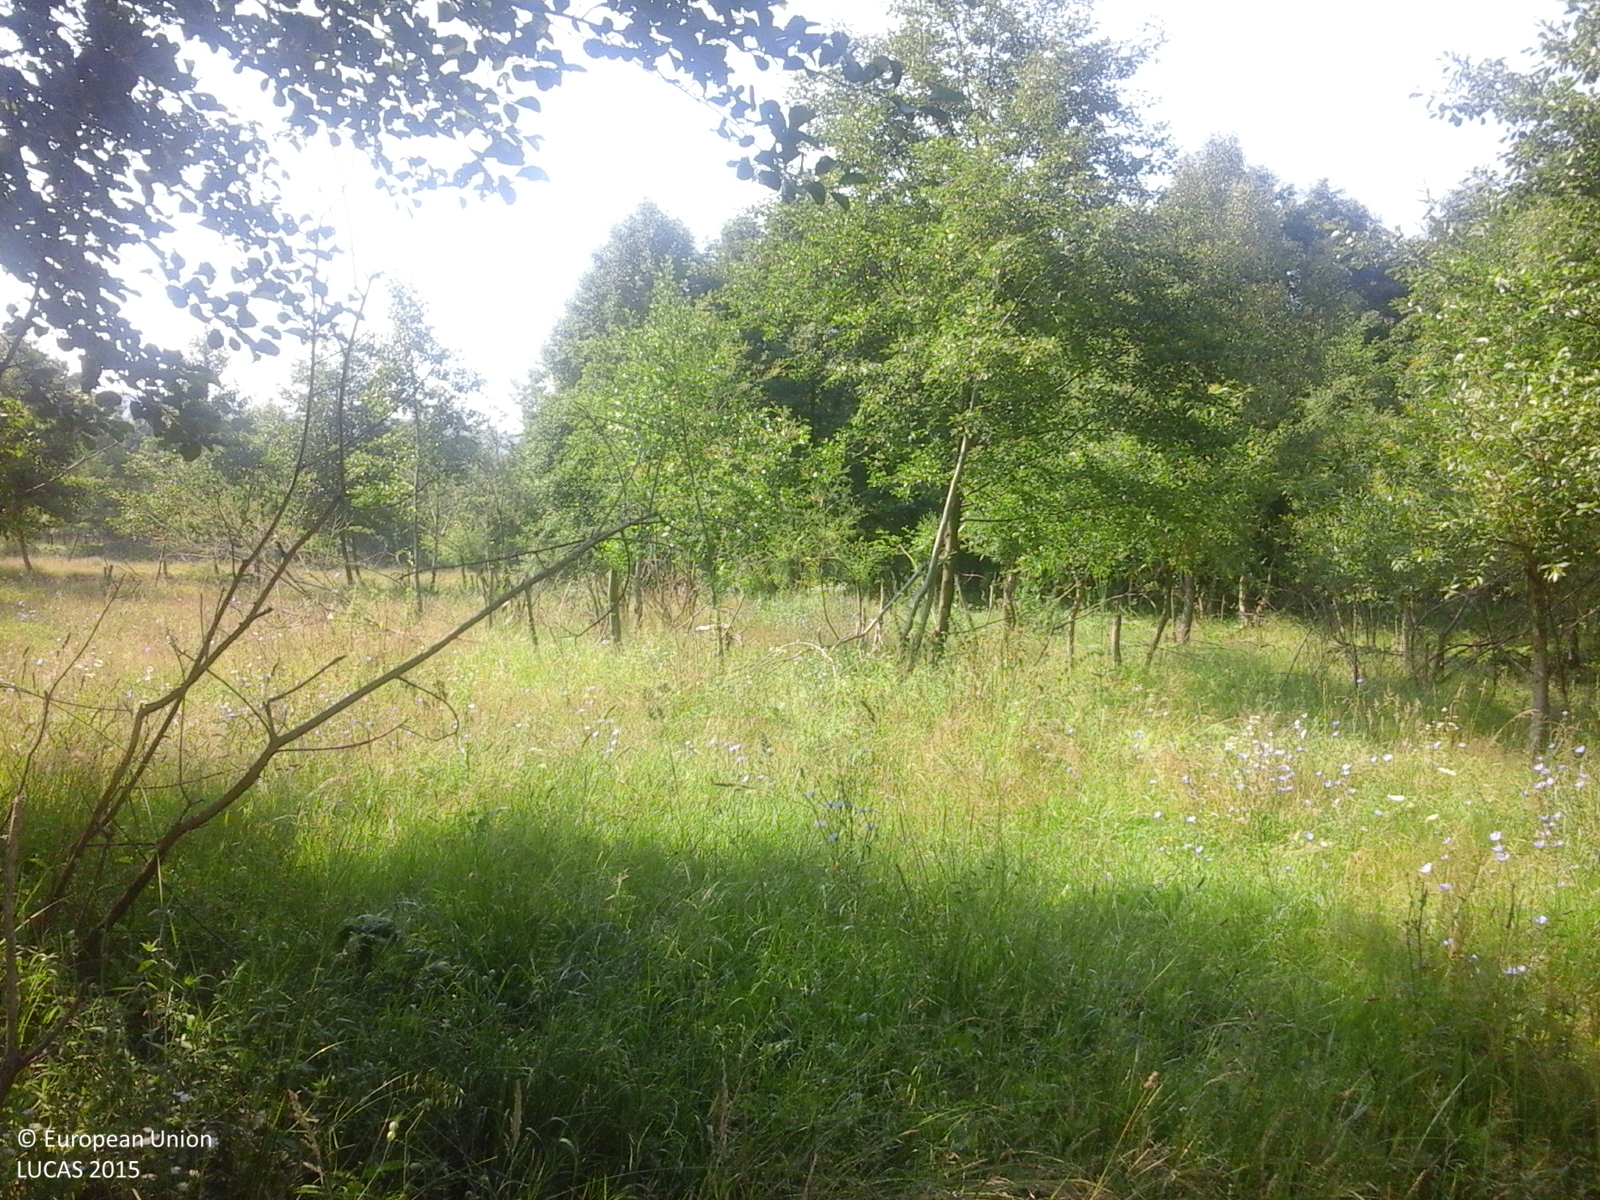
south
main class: Woodland
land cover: Broadleaved woodland
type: beech forest
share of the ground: > 75 %
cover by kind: broadleaved forest trees 100 %
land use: Forestry
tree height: > 5 m
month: July
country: RO
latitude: 45.1245
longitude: 25.1034
